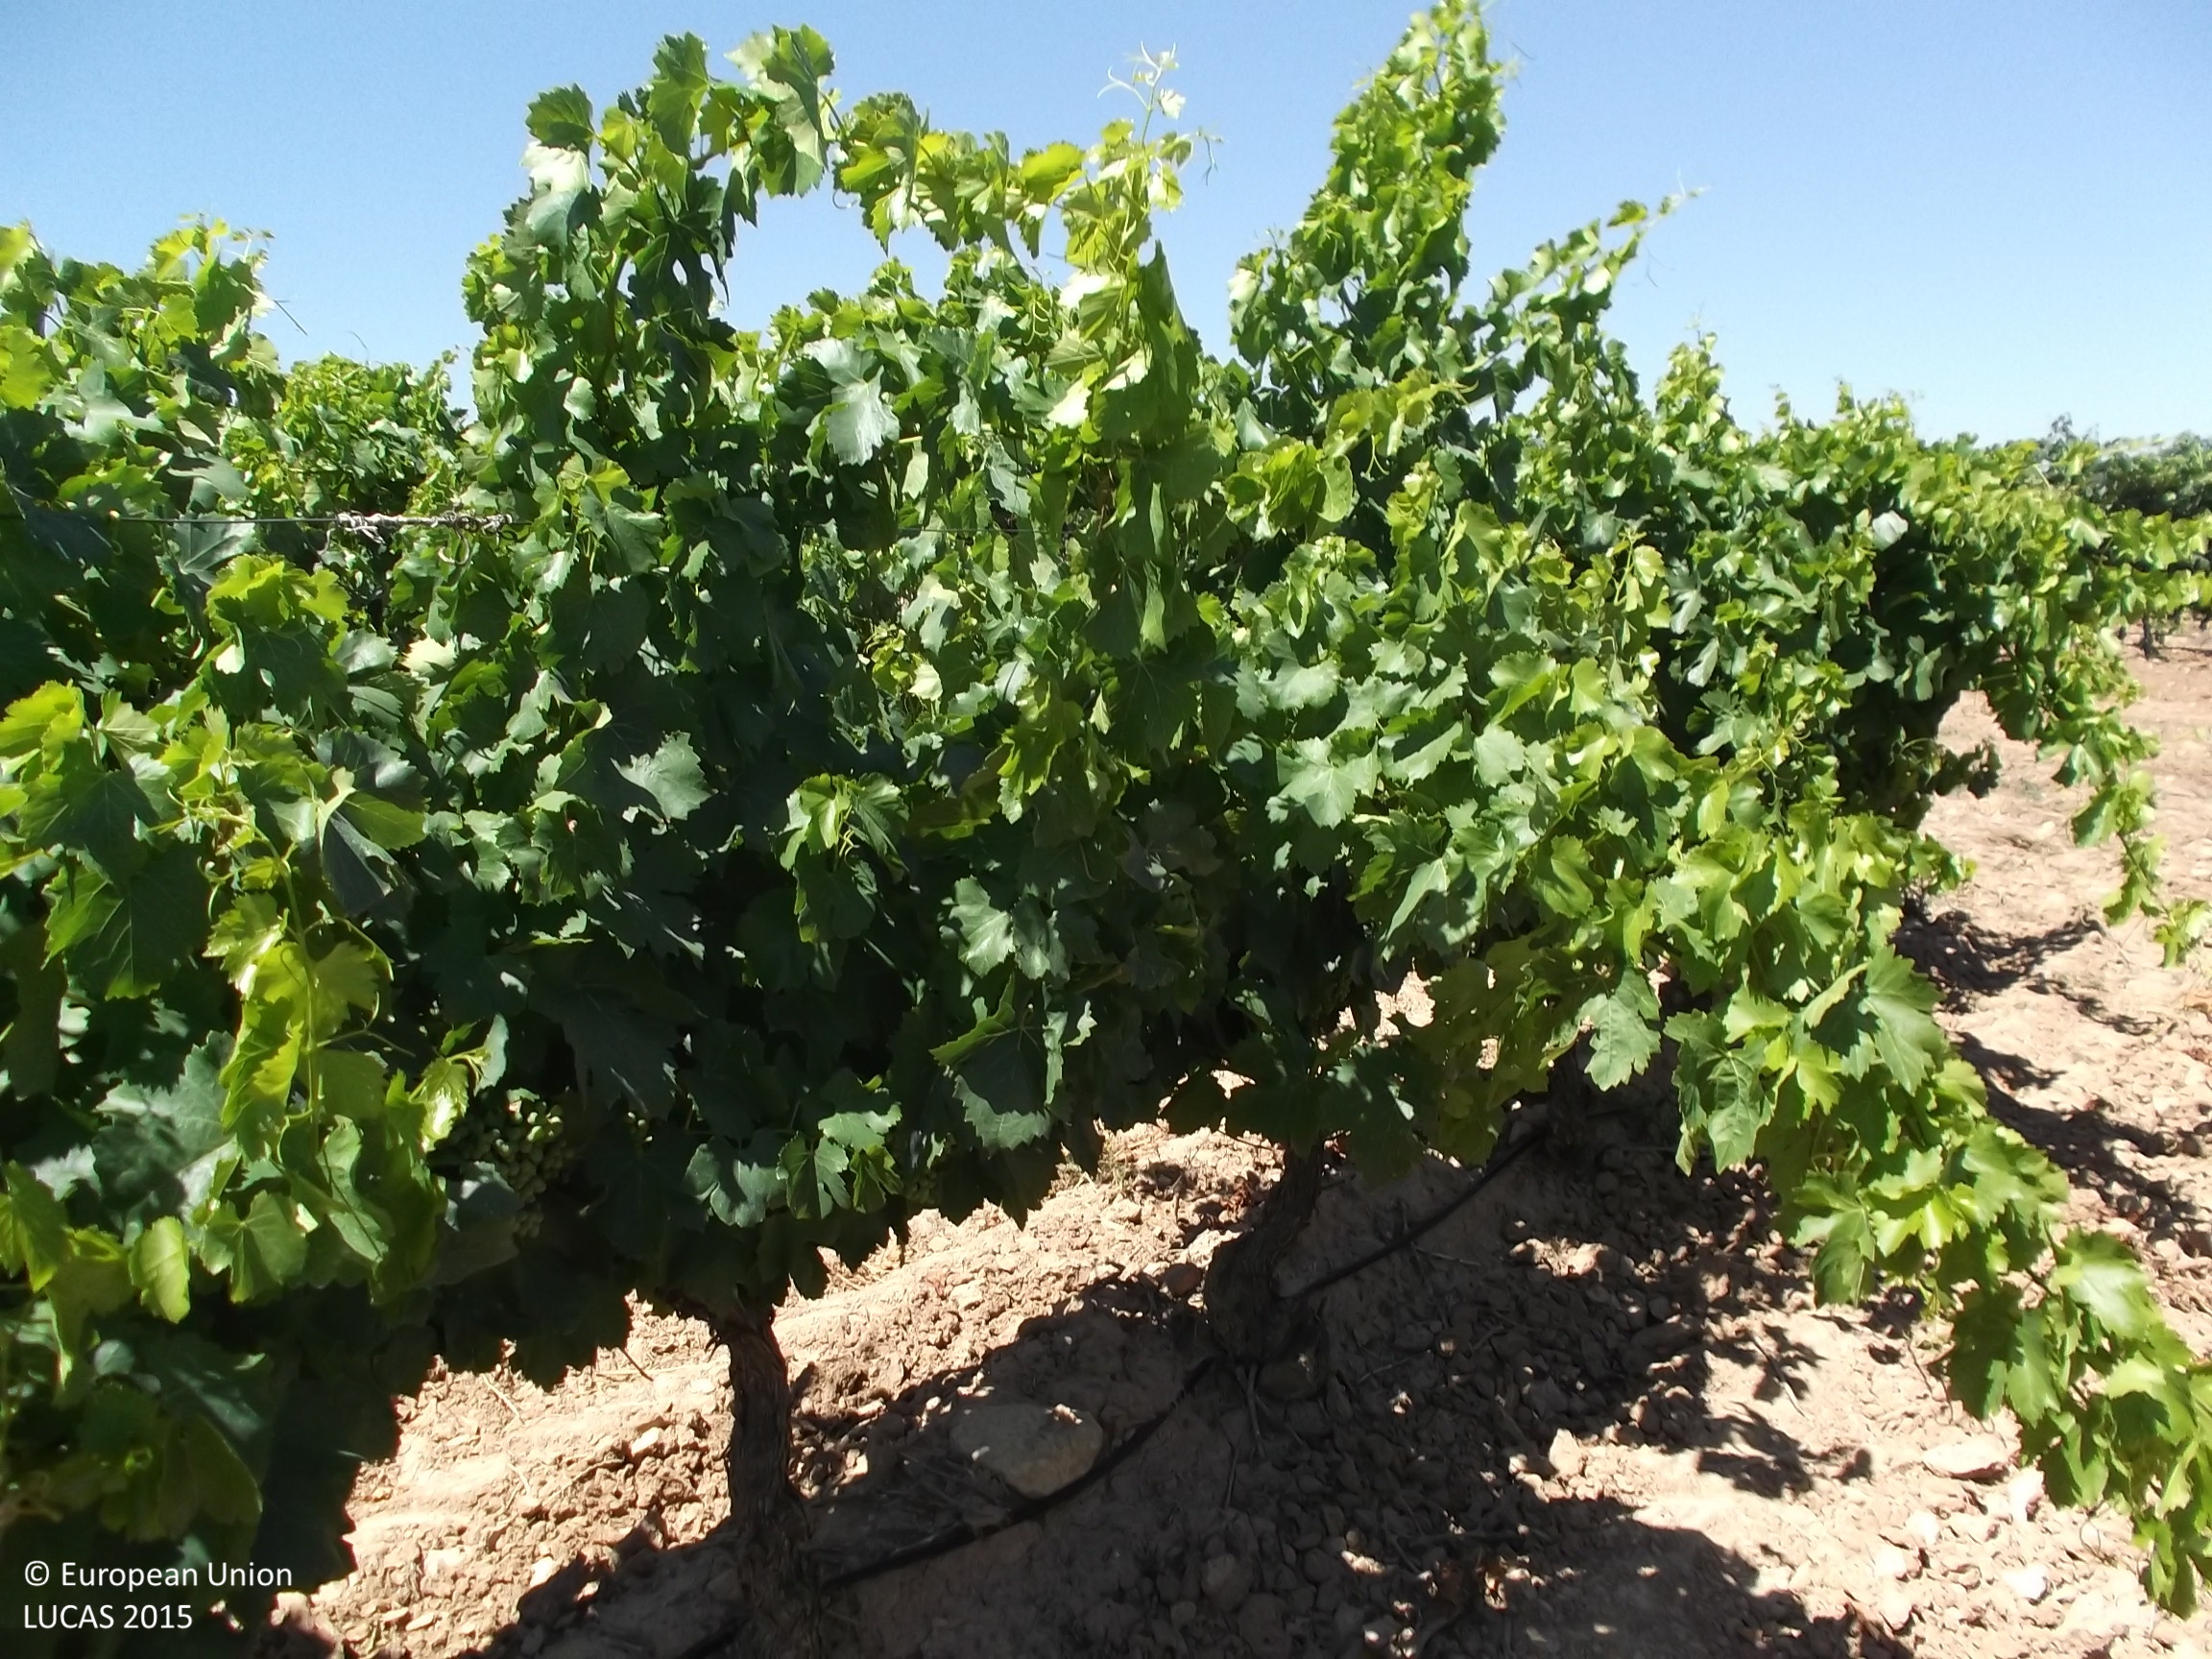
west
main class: Cropland
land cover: Vineyards
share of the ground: 25 - 50 %
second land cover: Other bare soil
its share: > 75 %
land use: Agriculture (excluding fallow land and kitchen gardens)
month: July
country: ES
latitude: 42.2600
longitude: -2.0515
